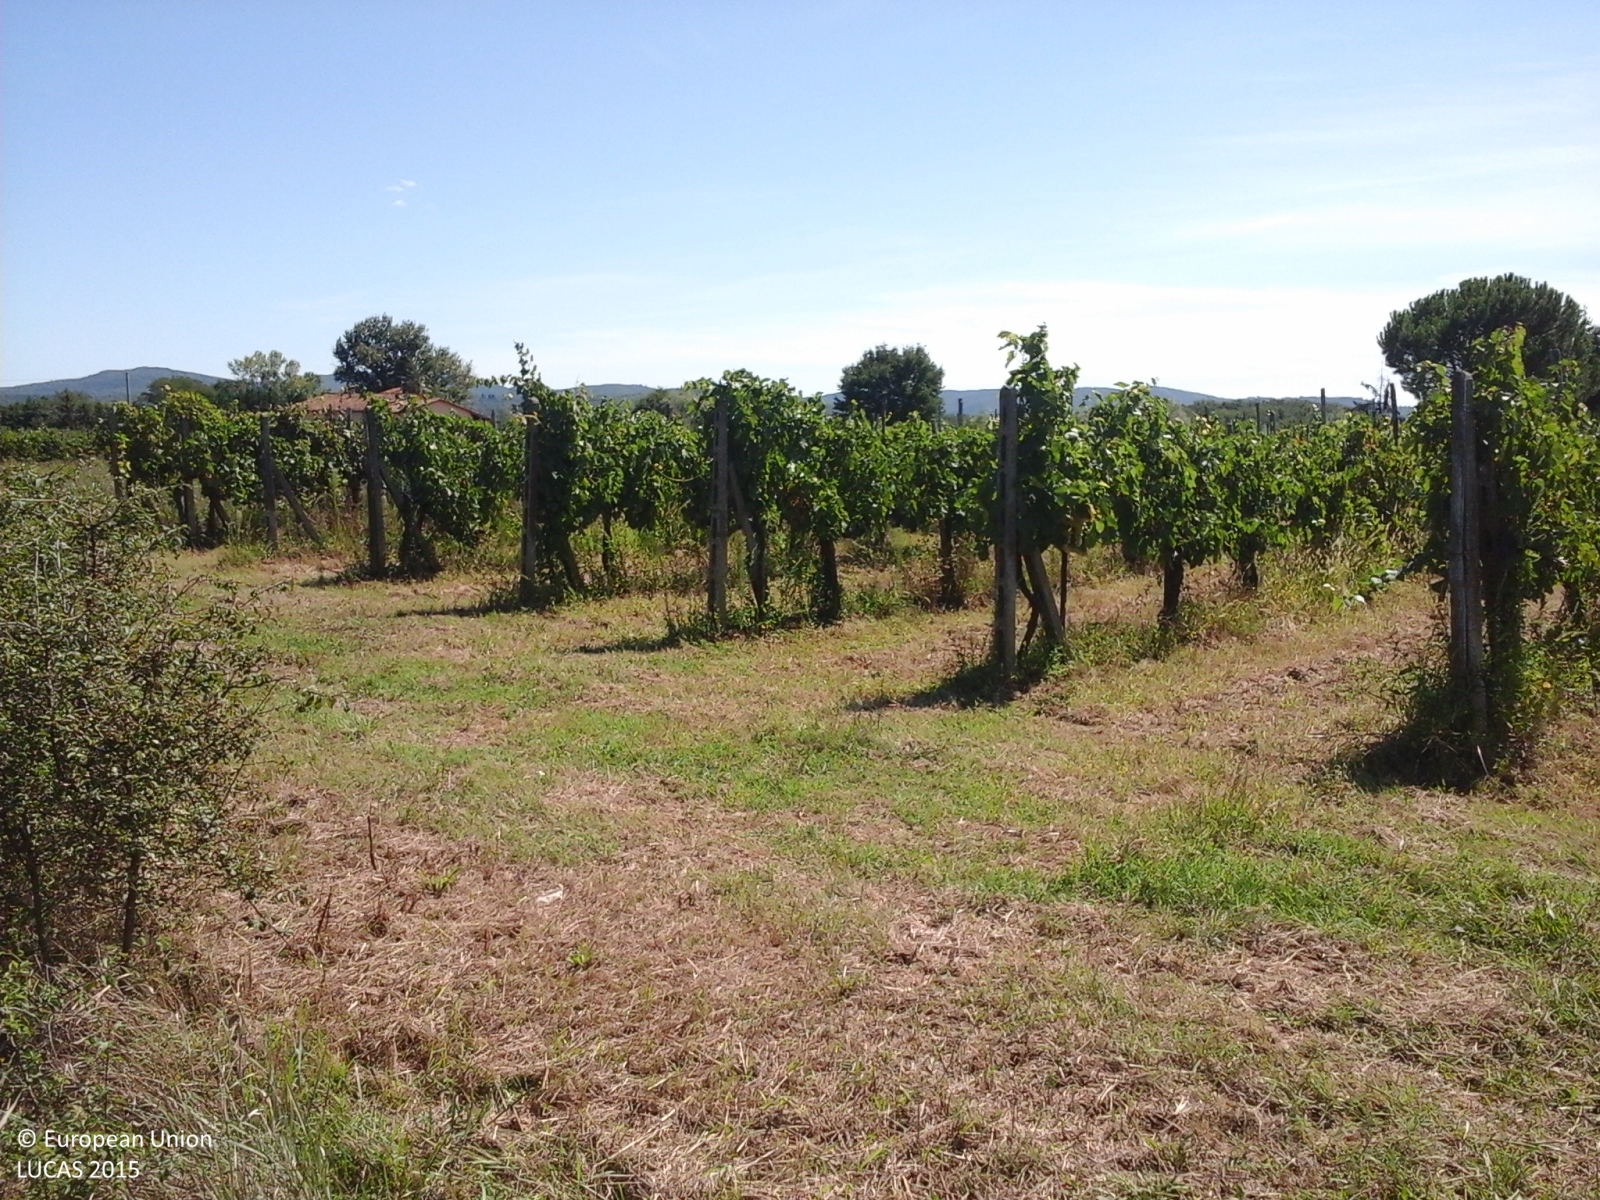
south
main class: Cropland
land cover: Vineyards
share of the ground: 25 - 50 %
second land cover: Grassland without tree/shrub cover
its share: > 75 %
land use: Agriculture (excluding fallow land and kitchen gardens)
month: September
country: IT
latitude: 43.4722
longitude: 11.5903
